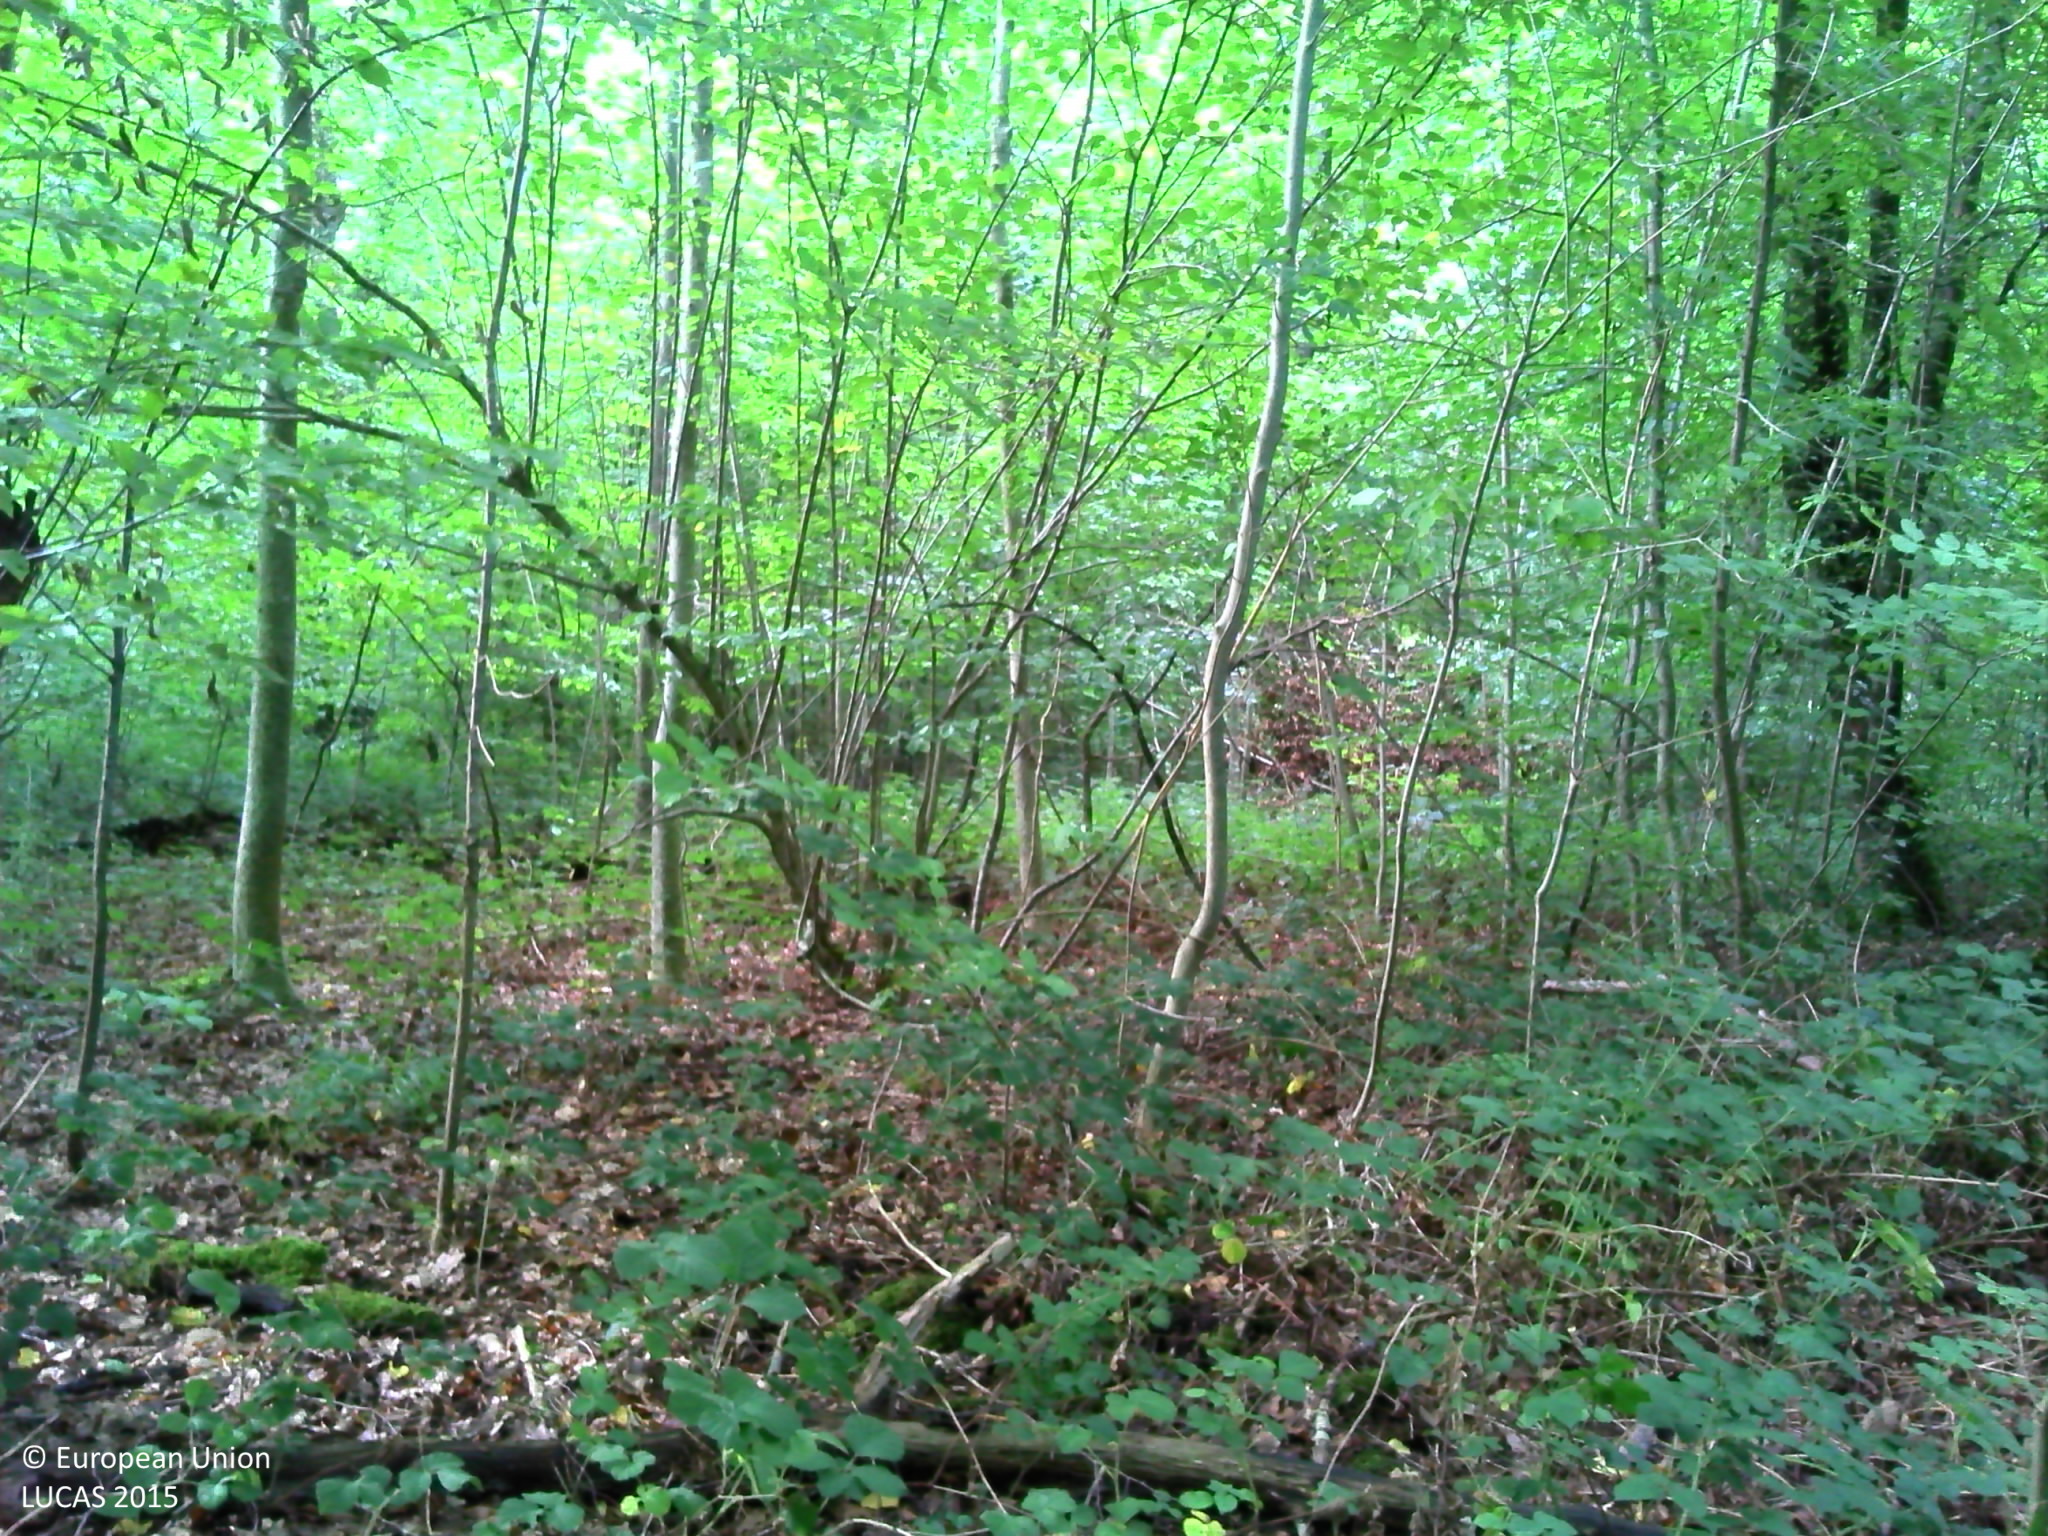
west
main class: Woodland
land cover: Broadleaved woodland
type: mesophytic deciduous forest
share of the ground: > 75 %
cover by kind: broadleaved forest trees 90 %, herbaceous plants 5 %, consolidated bare surface 5 %
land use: Forestry
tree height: > 5 m
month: September
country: FR
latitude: 48.8538
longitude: 6.0064
